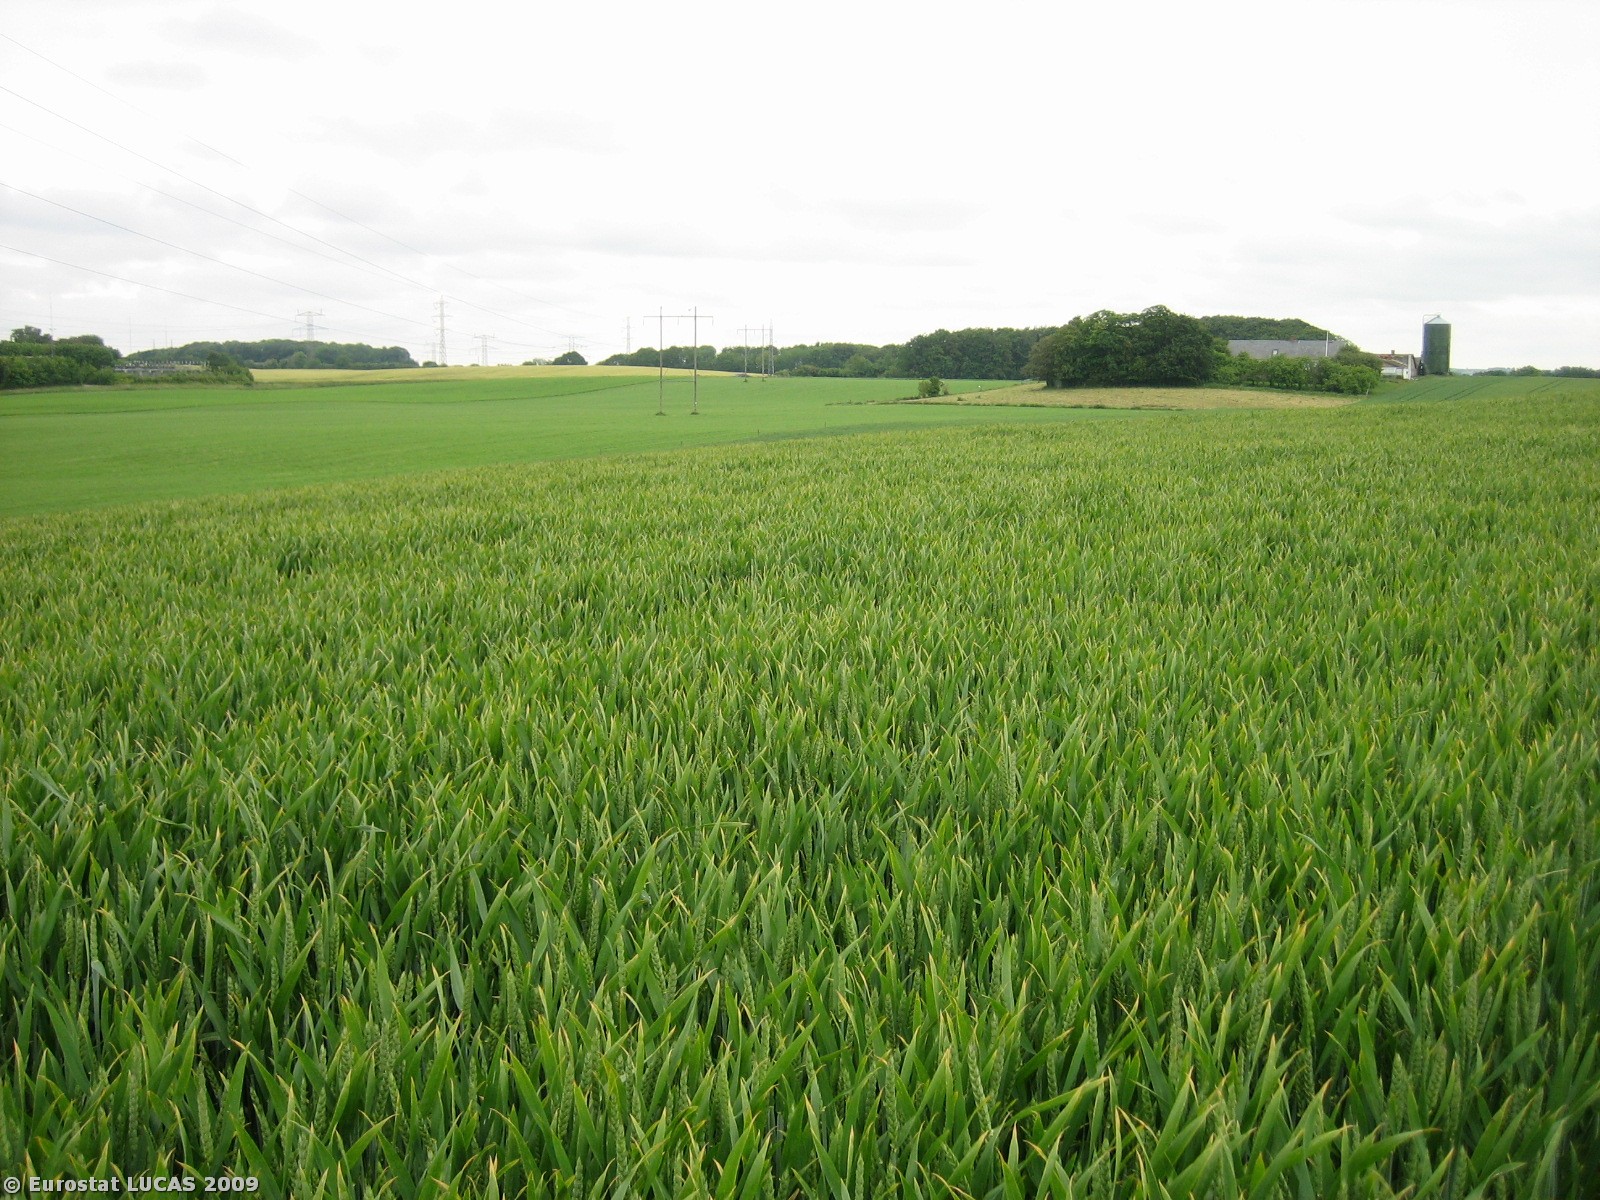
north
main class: Cropland
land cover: Common wheat
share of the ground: > 75 %
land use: Agriculture (excluding fallow land and kitchen gardens)
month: June
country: DK
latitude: 56.0438
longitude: 10.1443
